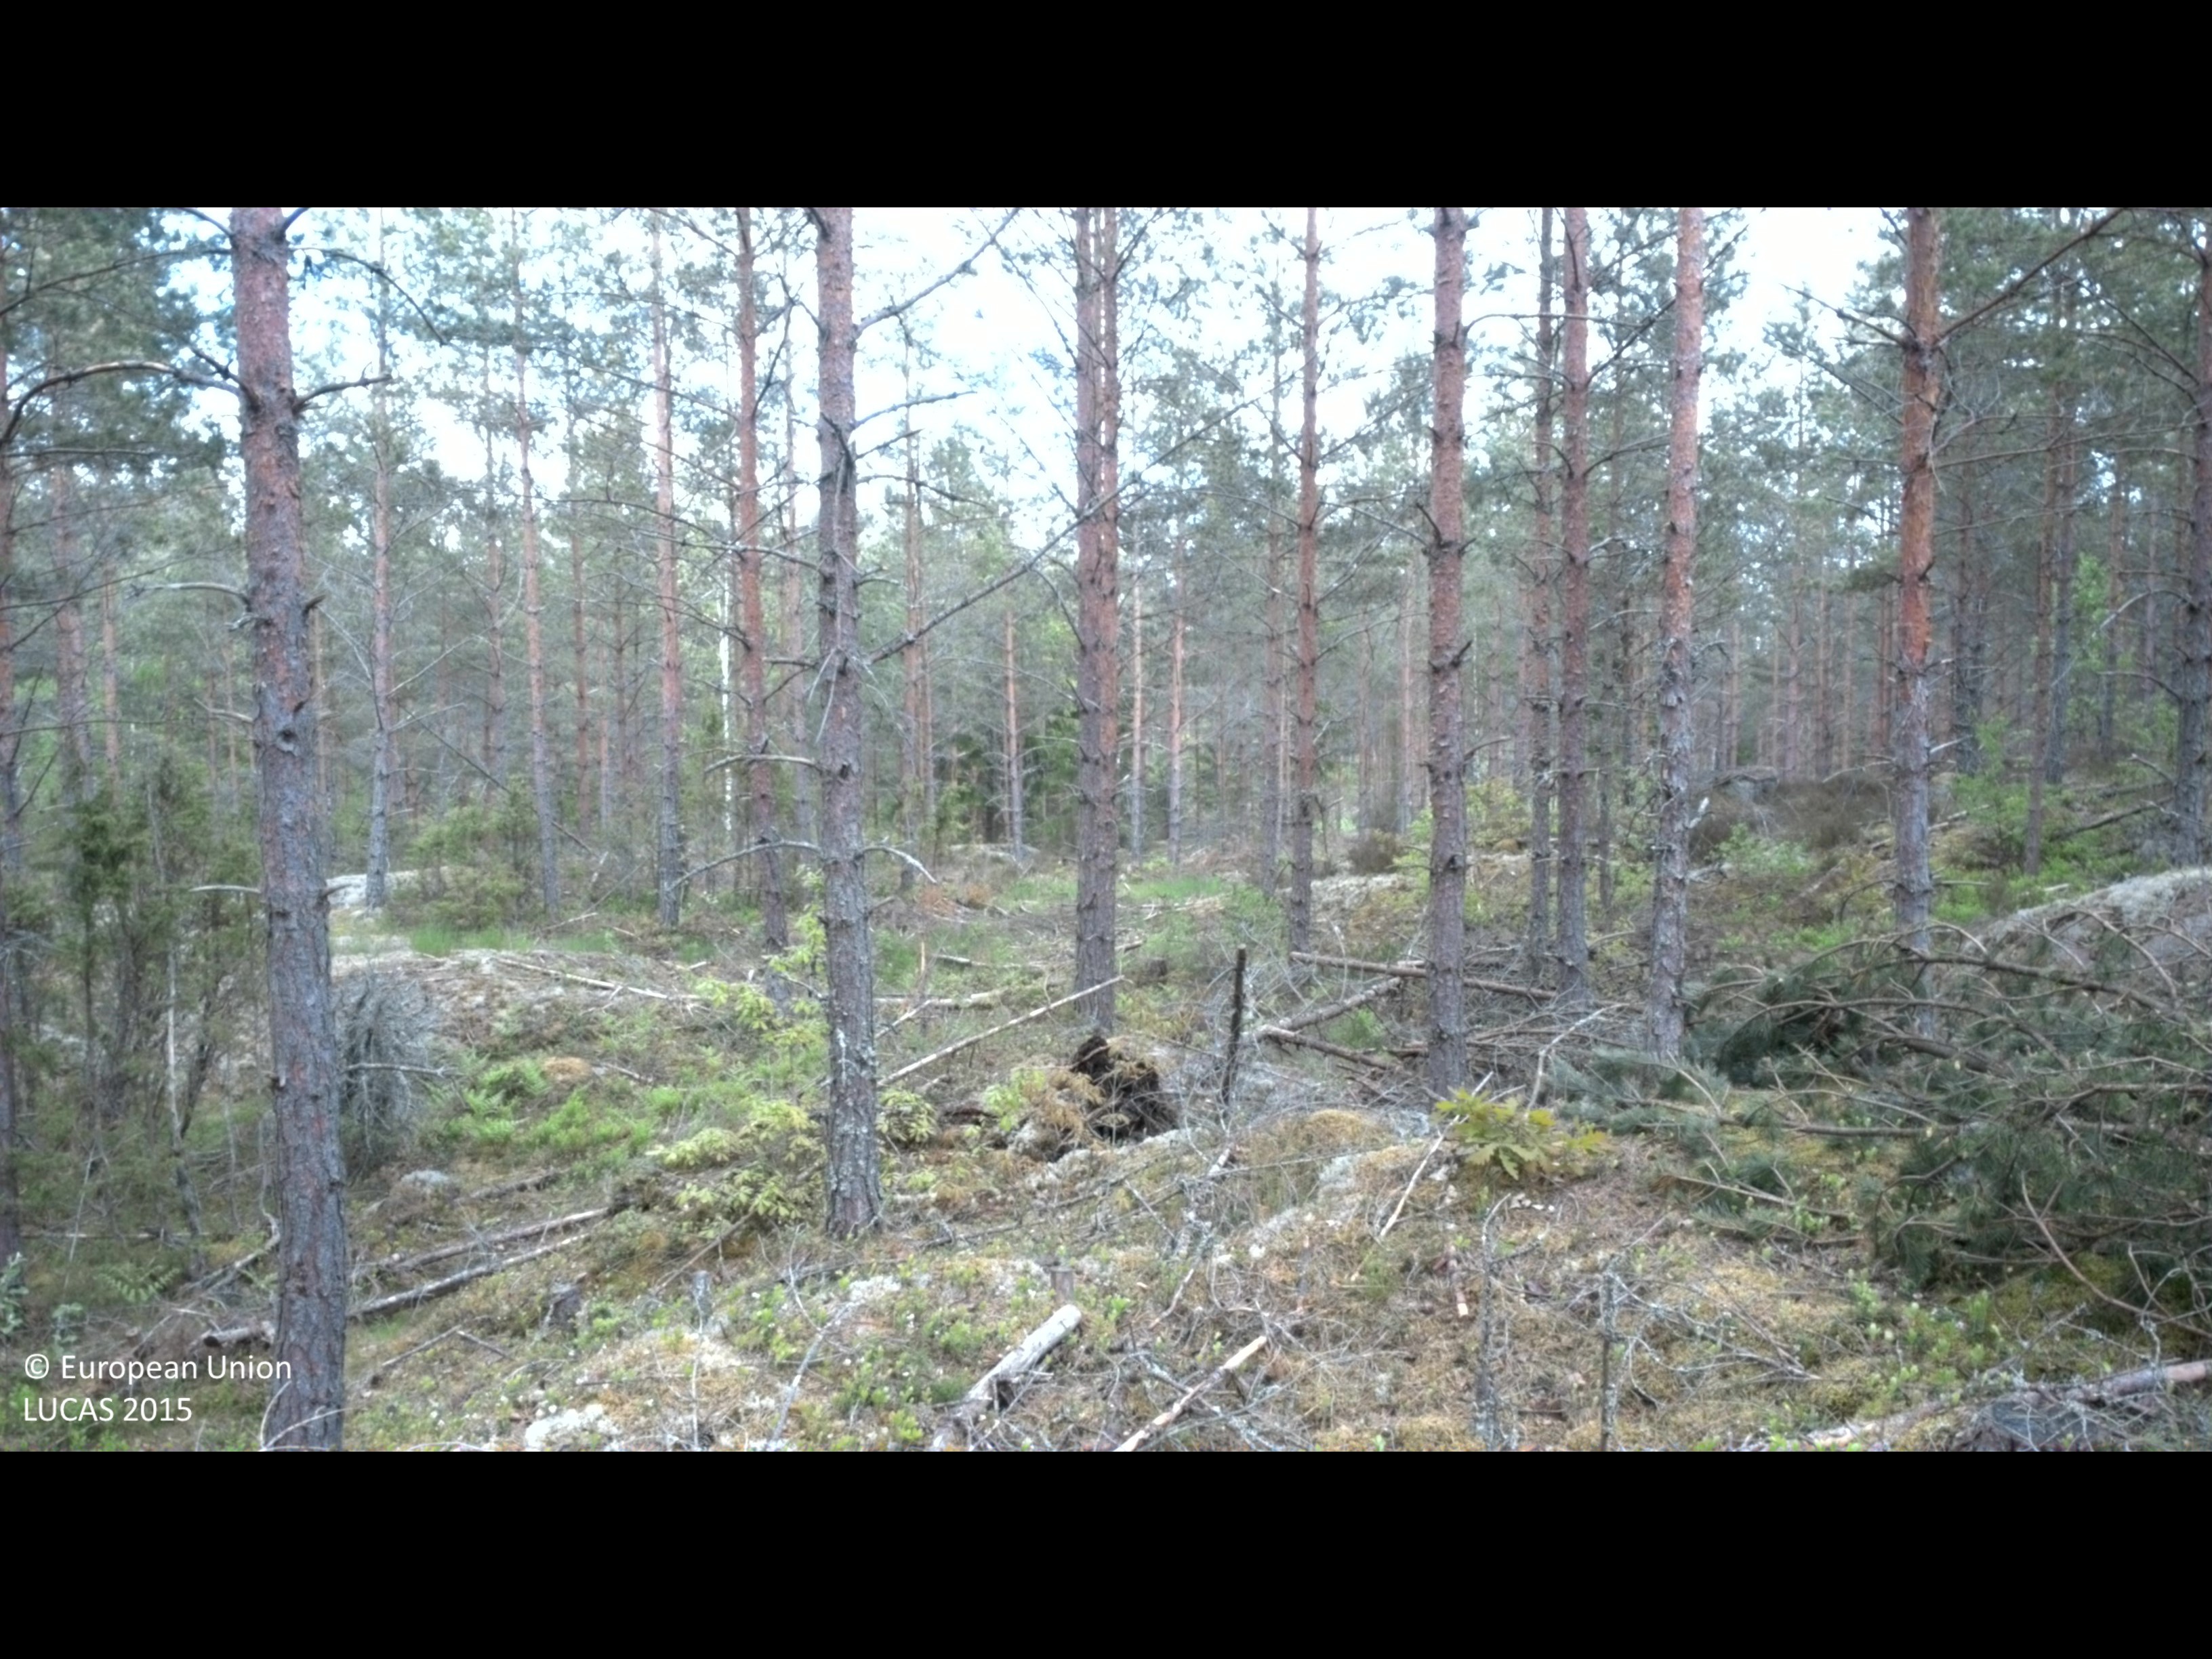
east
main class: Woodland
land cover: Pine dominated coniferous woodland
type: boreal forest
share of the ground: 50 - 75 %
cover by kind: coniferous forest trees 65 %, shrubs 15 %, lichens and mosses 15 %, herbaceous plants 5 %
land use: Forestry
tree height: > 5 m
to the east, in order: Pine dominated coniferous woodland; Ditches and canals; Grassland without tree/shrub cover; Ditches and canals; Grassland without tree/shrub cover; Pine dominated coniferous woodland; Paved roads, cycling and walking lanes; Pine dominated coniferous woodland; Shrubland with sparse tree cover; Electric lines; Pine dominated coniferous woodland
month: May
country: SE
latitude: 57.5015
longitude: 16.5242
